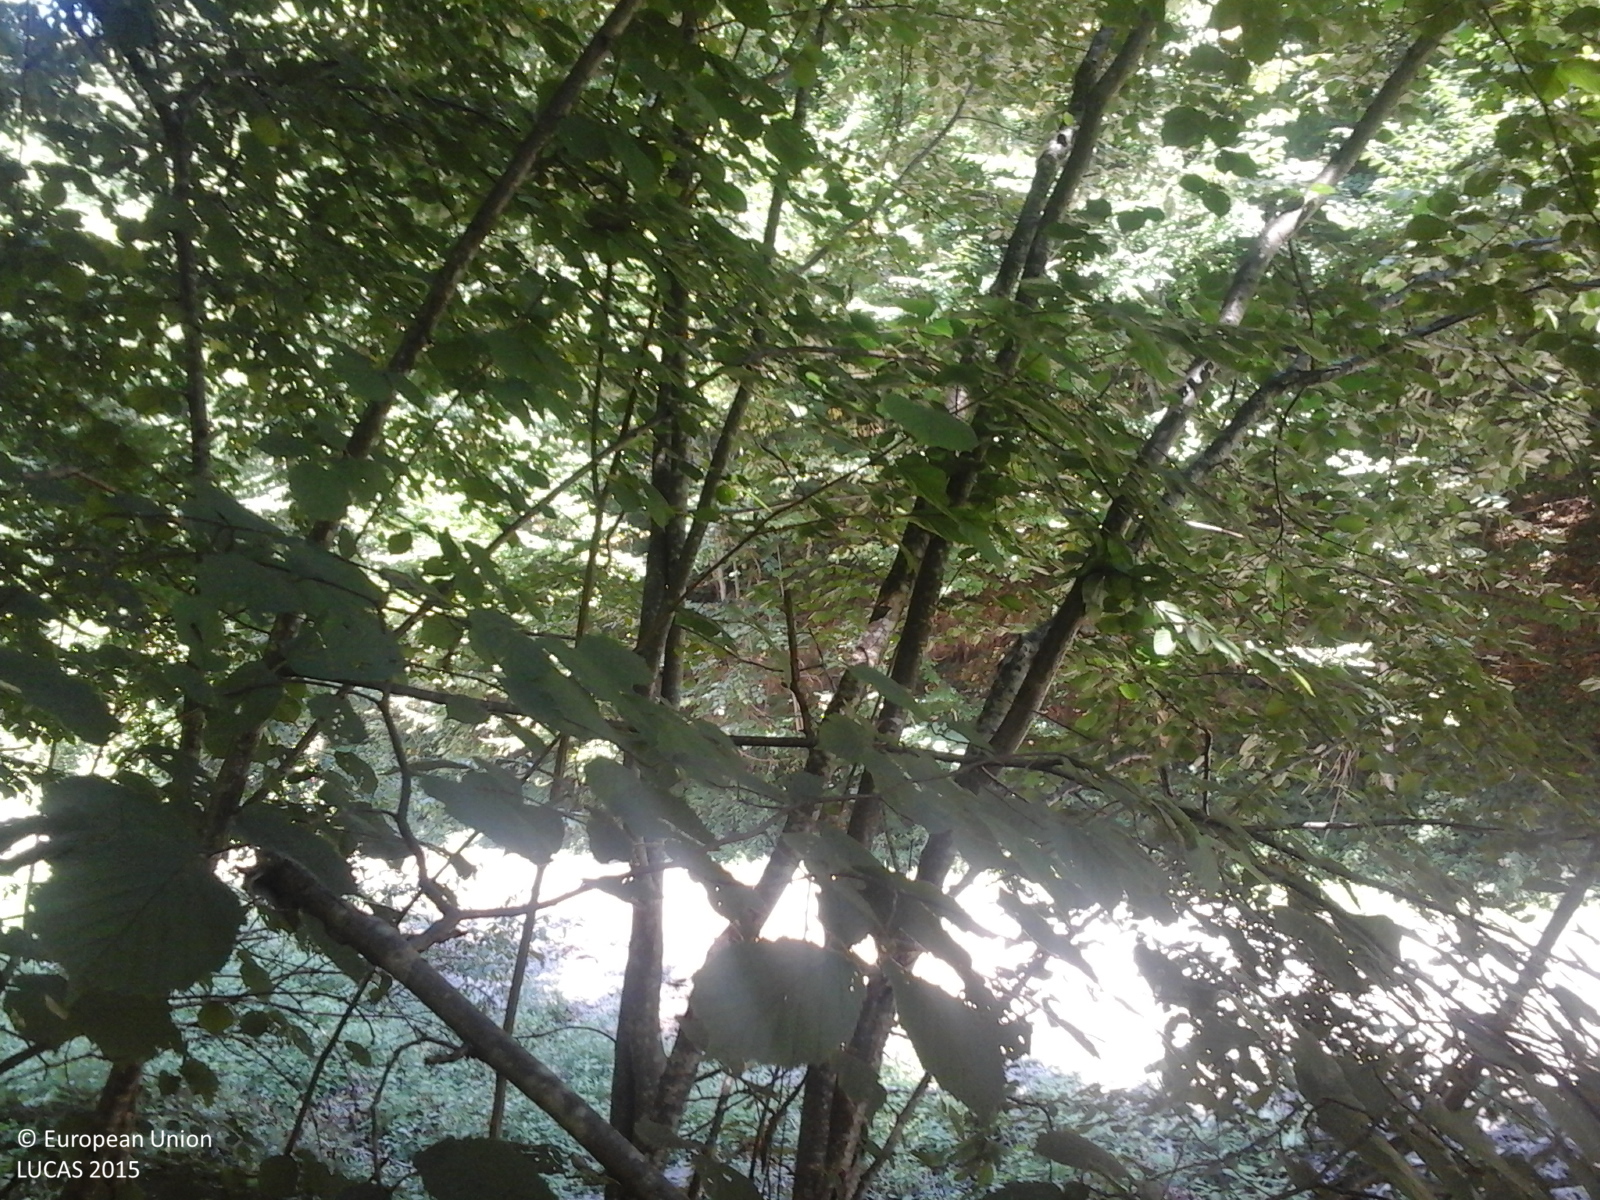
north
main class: Woodland
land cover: Broadleaved woodland
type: non-riverine alder, birch or aspen forest
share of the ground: > 75 %
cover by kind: broadleaved forest trees 100 %
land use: Forestry
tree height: > 5 m
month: August
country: RO
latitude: 46.4724
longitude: 22.3301
